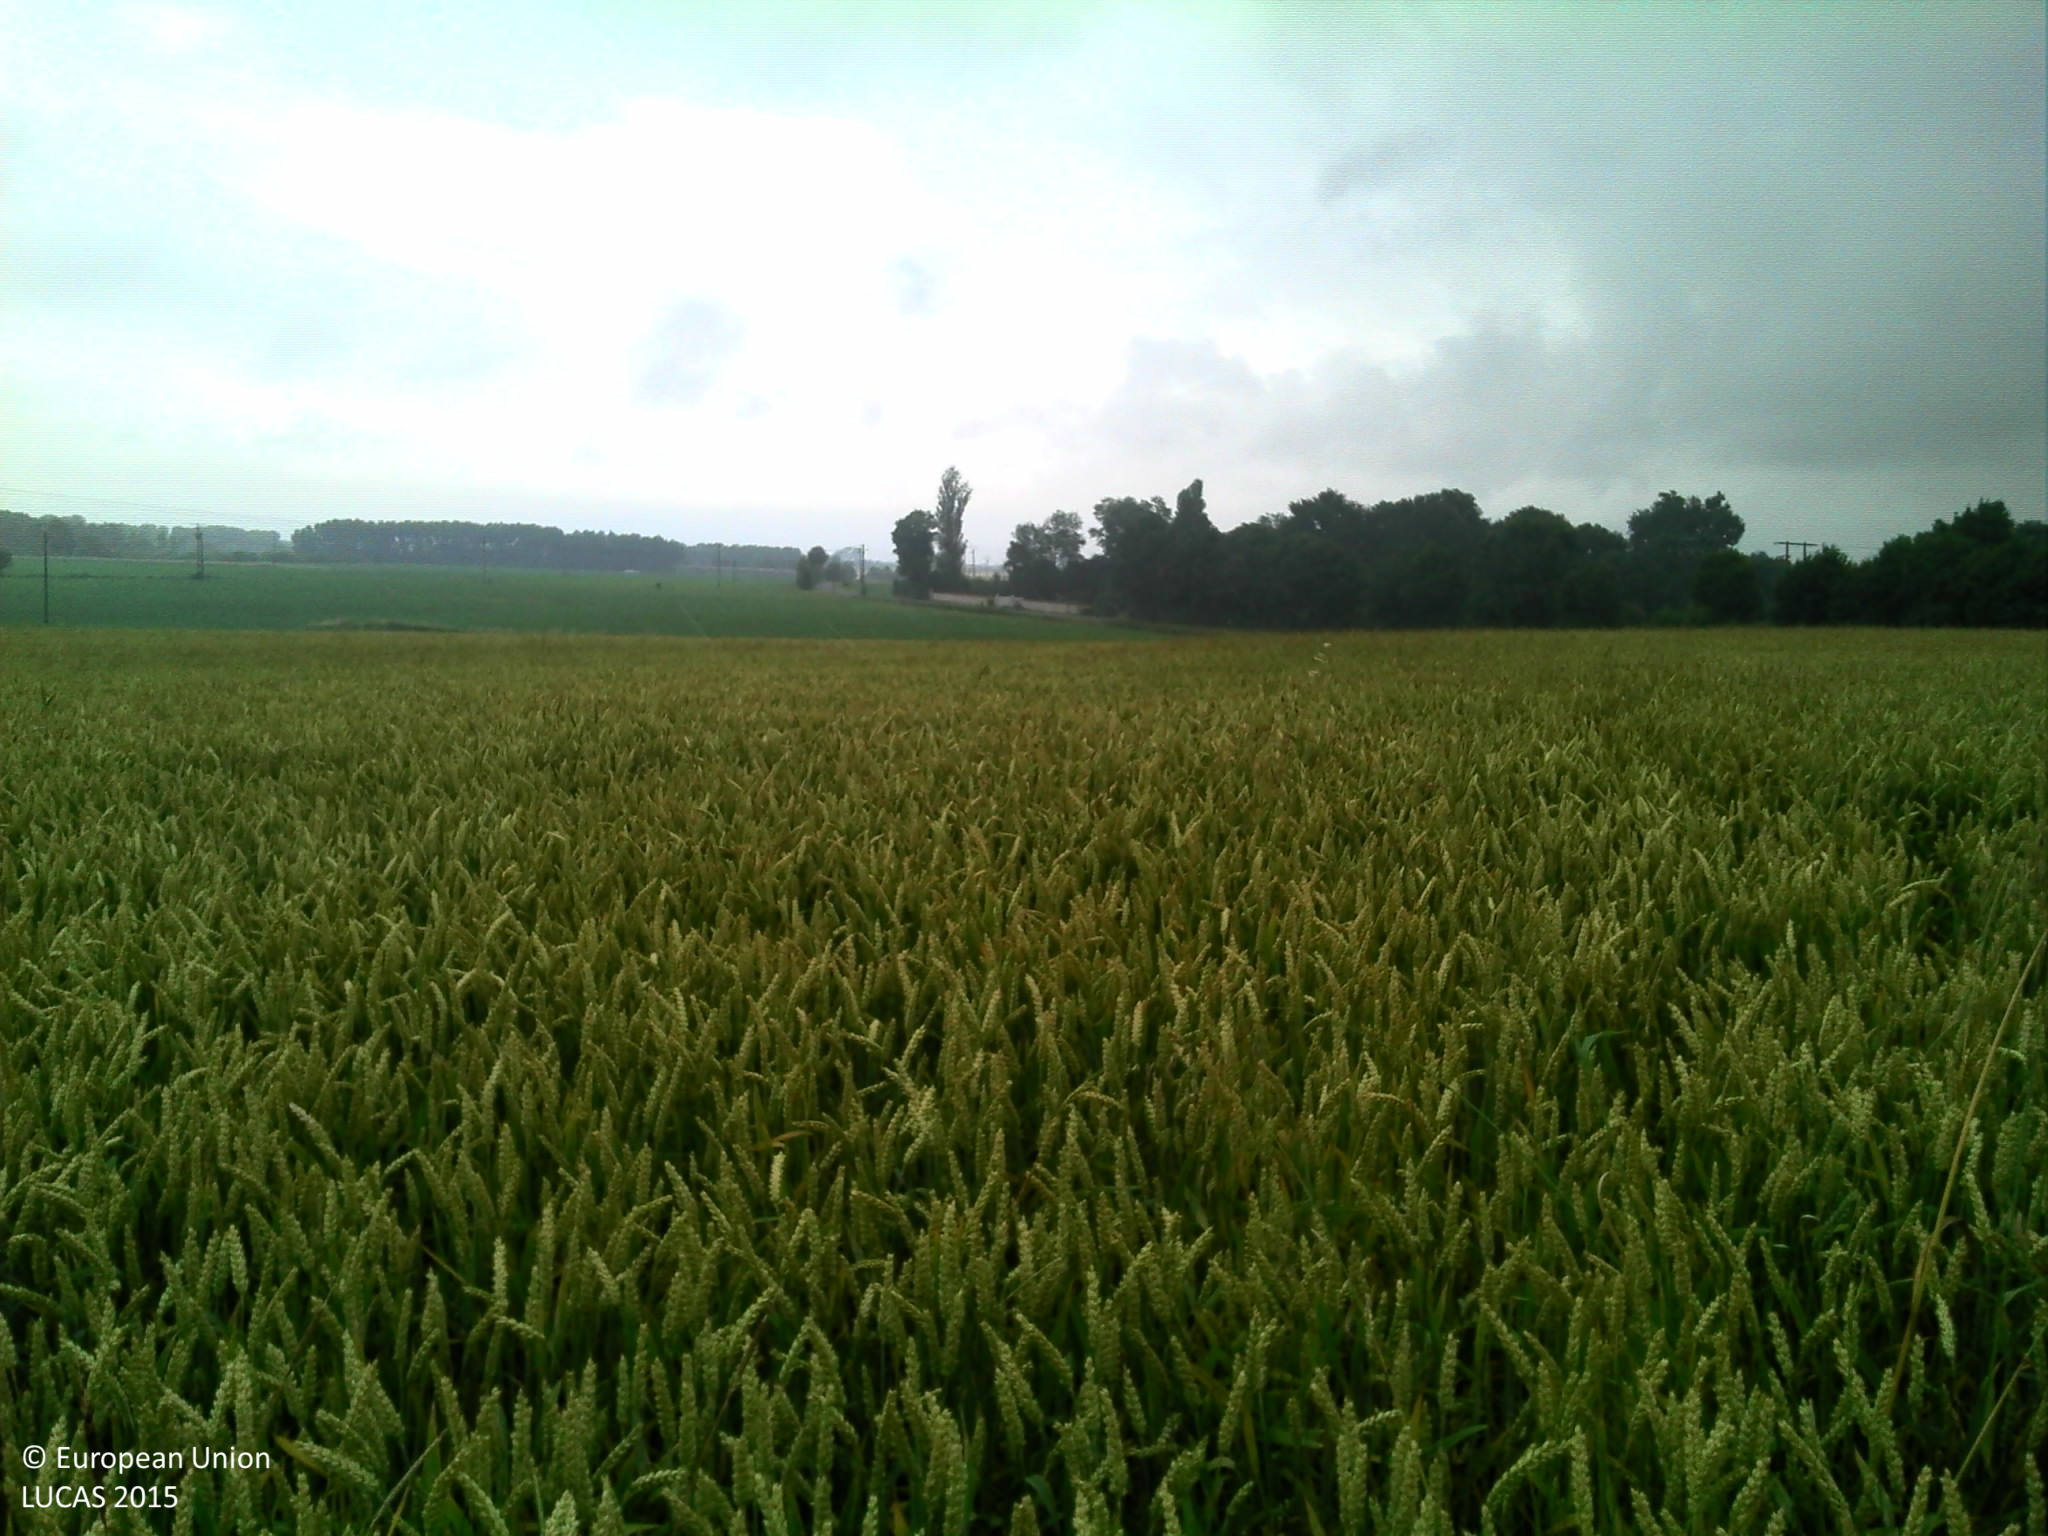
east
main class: Cropland
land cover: Common wheat
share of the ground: > 75 %
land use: Agriculture (excluding fallow land and kitchen gardens)
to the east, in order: Common wheat; Maize; Grass margins; Paved roads, cycling and walking lanes; Grass margins; Maize
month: June
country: FR
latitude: 45.9152
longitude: -0.7660
